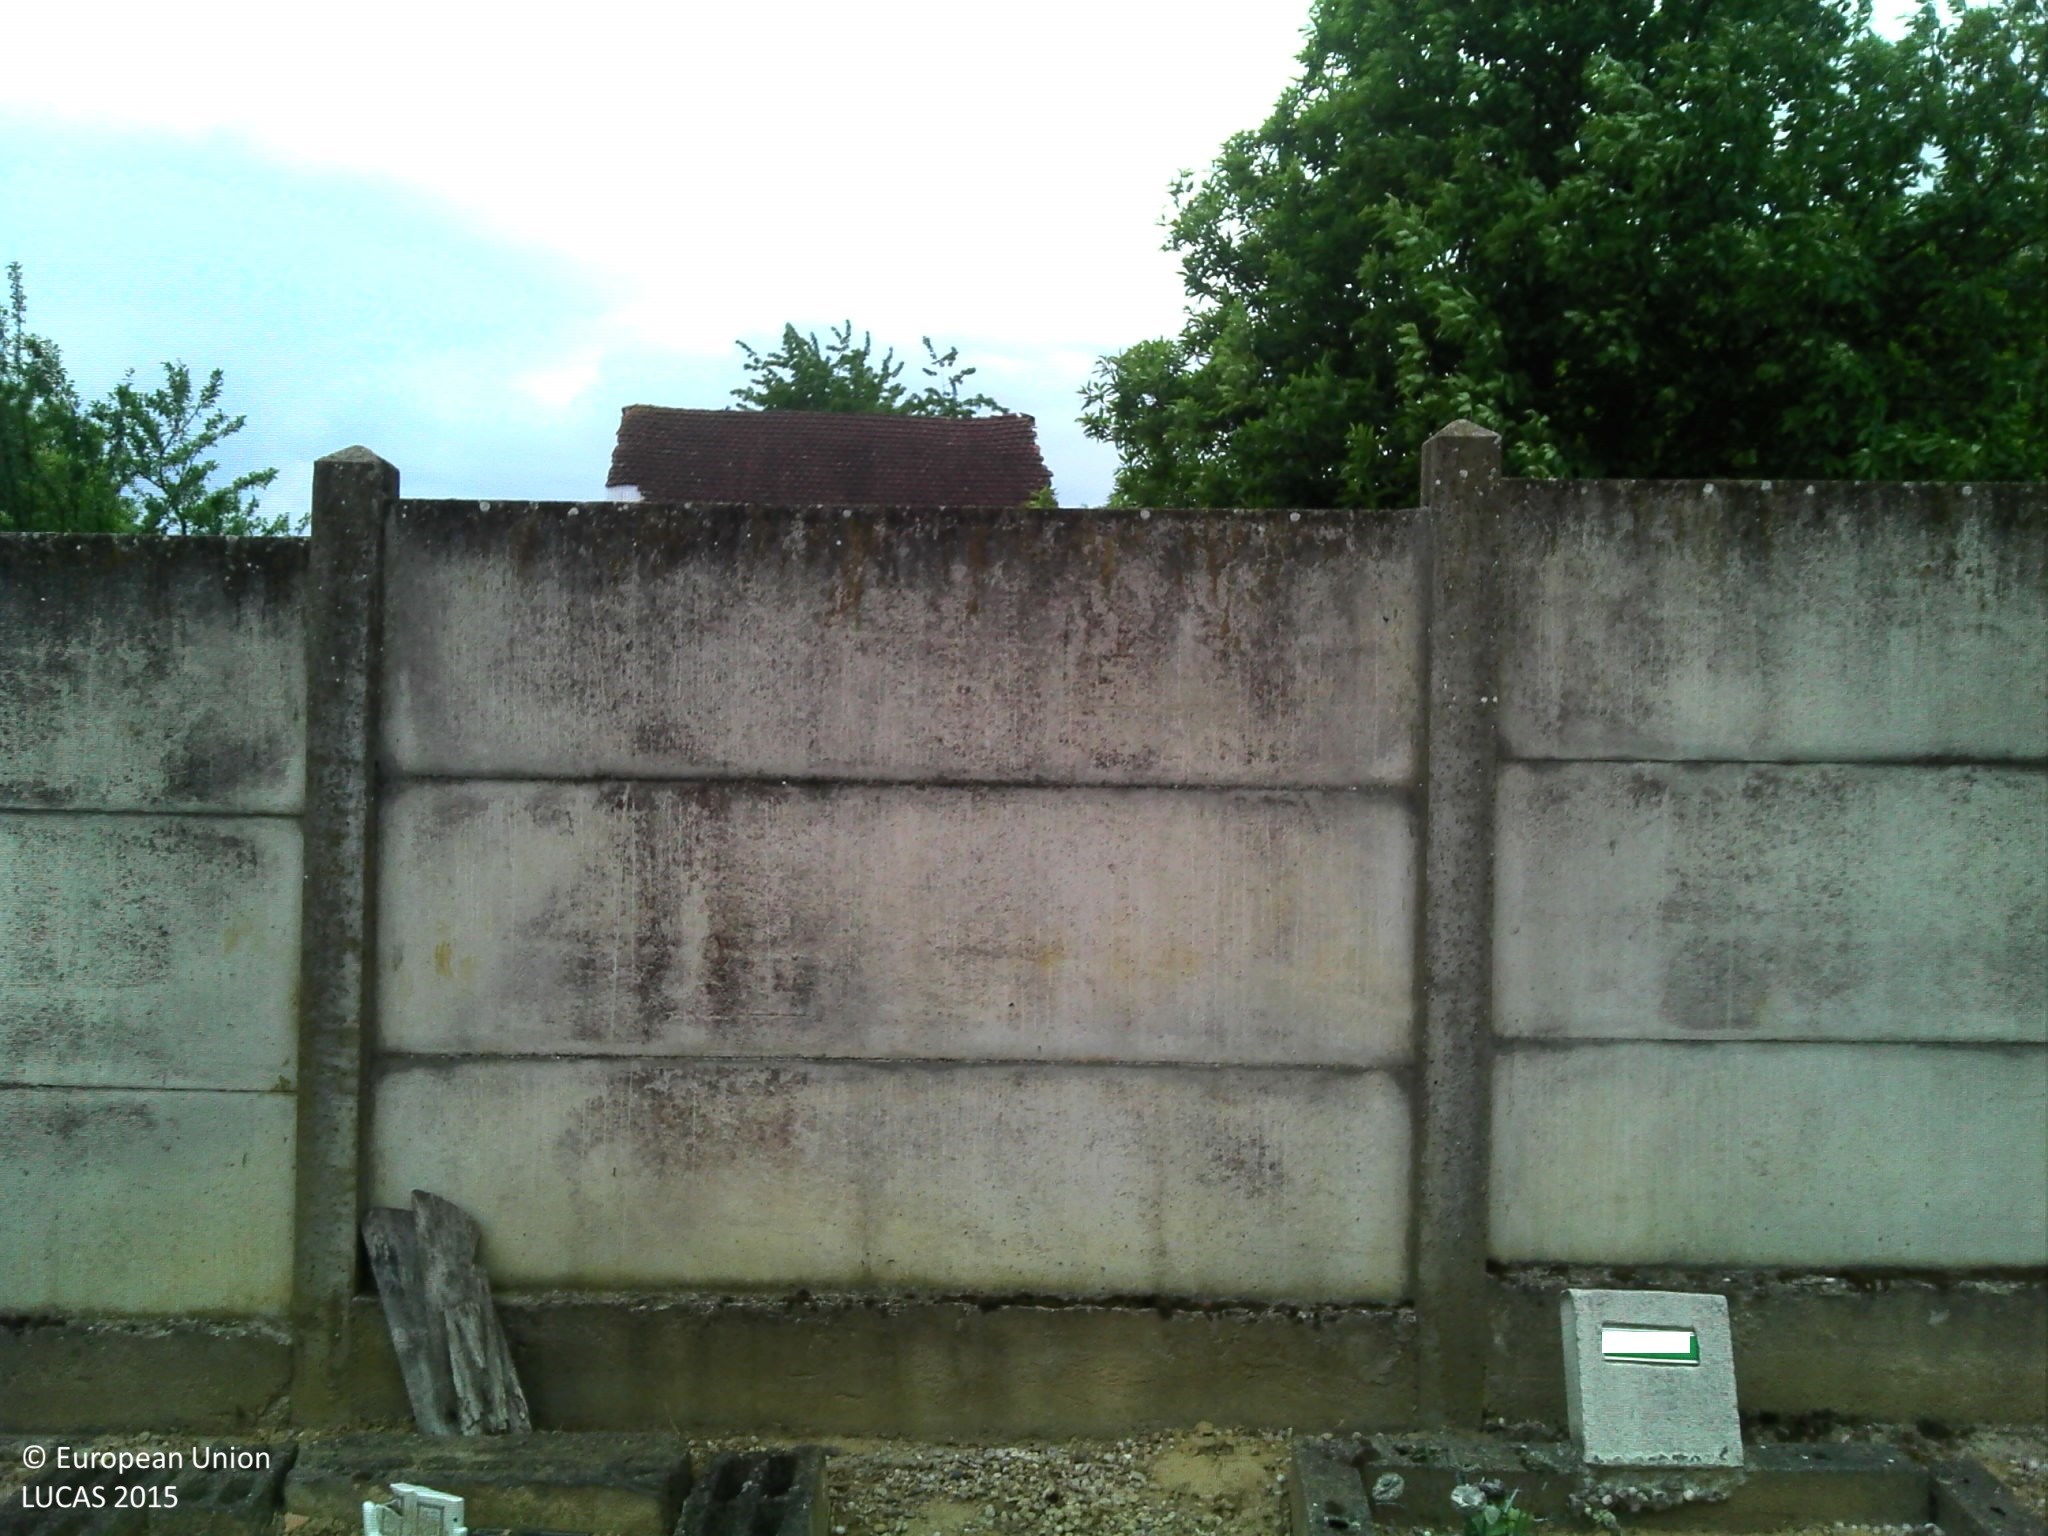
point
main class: Grassland
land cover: Grassland with sparse tree/shrub cover
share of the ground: > 75 %
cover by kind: herbaceous plants 95 %, broadleaved forest trees 5 %
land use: Agriculture (excluding fallow land and kitchen gardens)
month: May
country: FR
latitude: 47.8902
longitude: 6.2695
